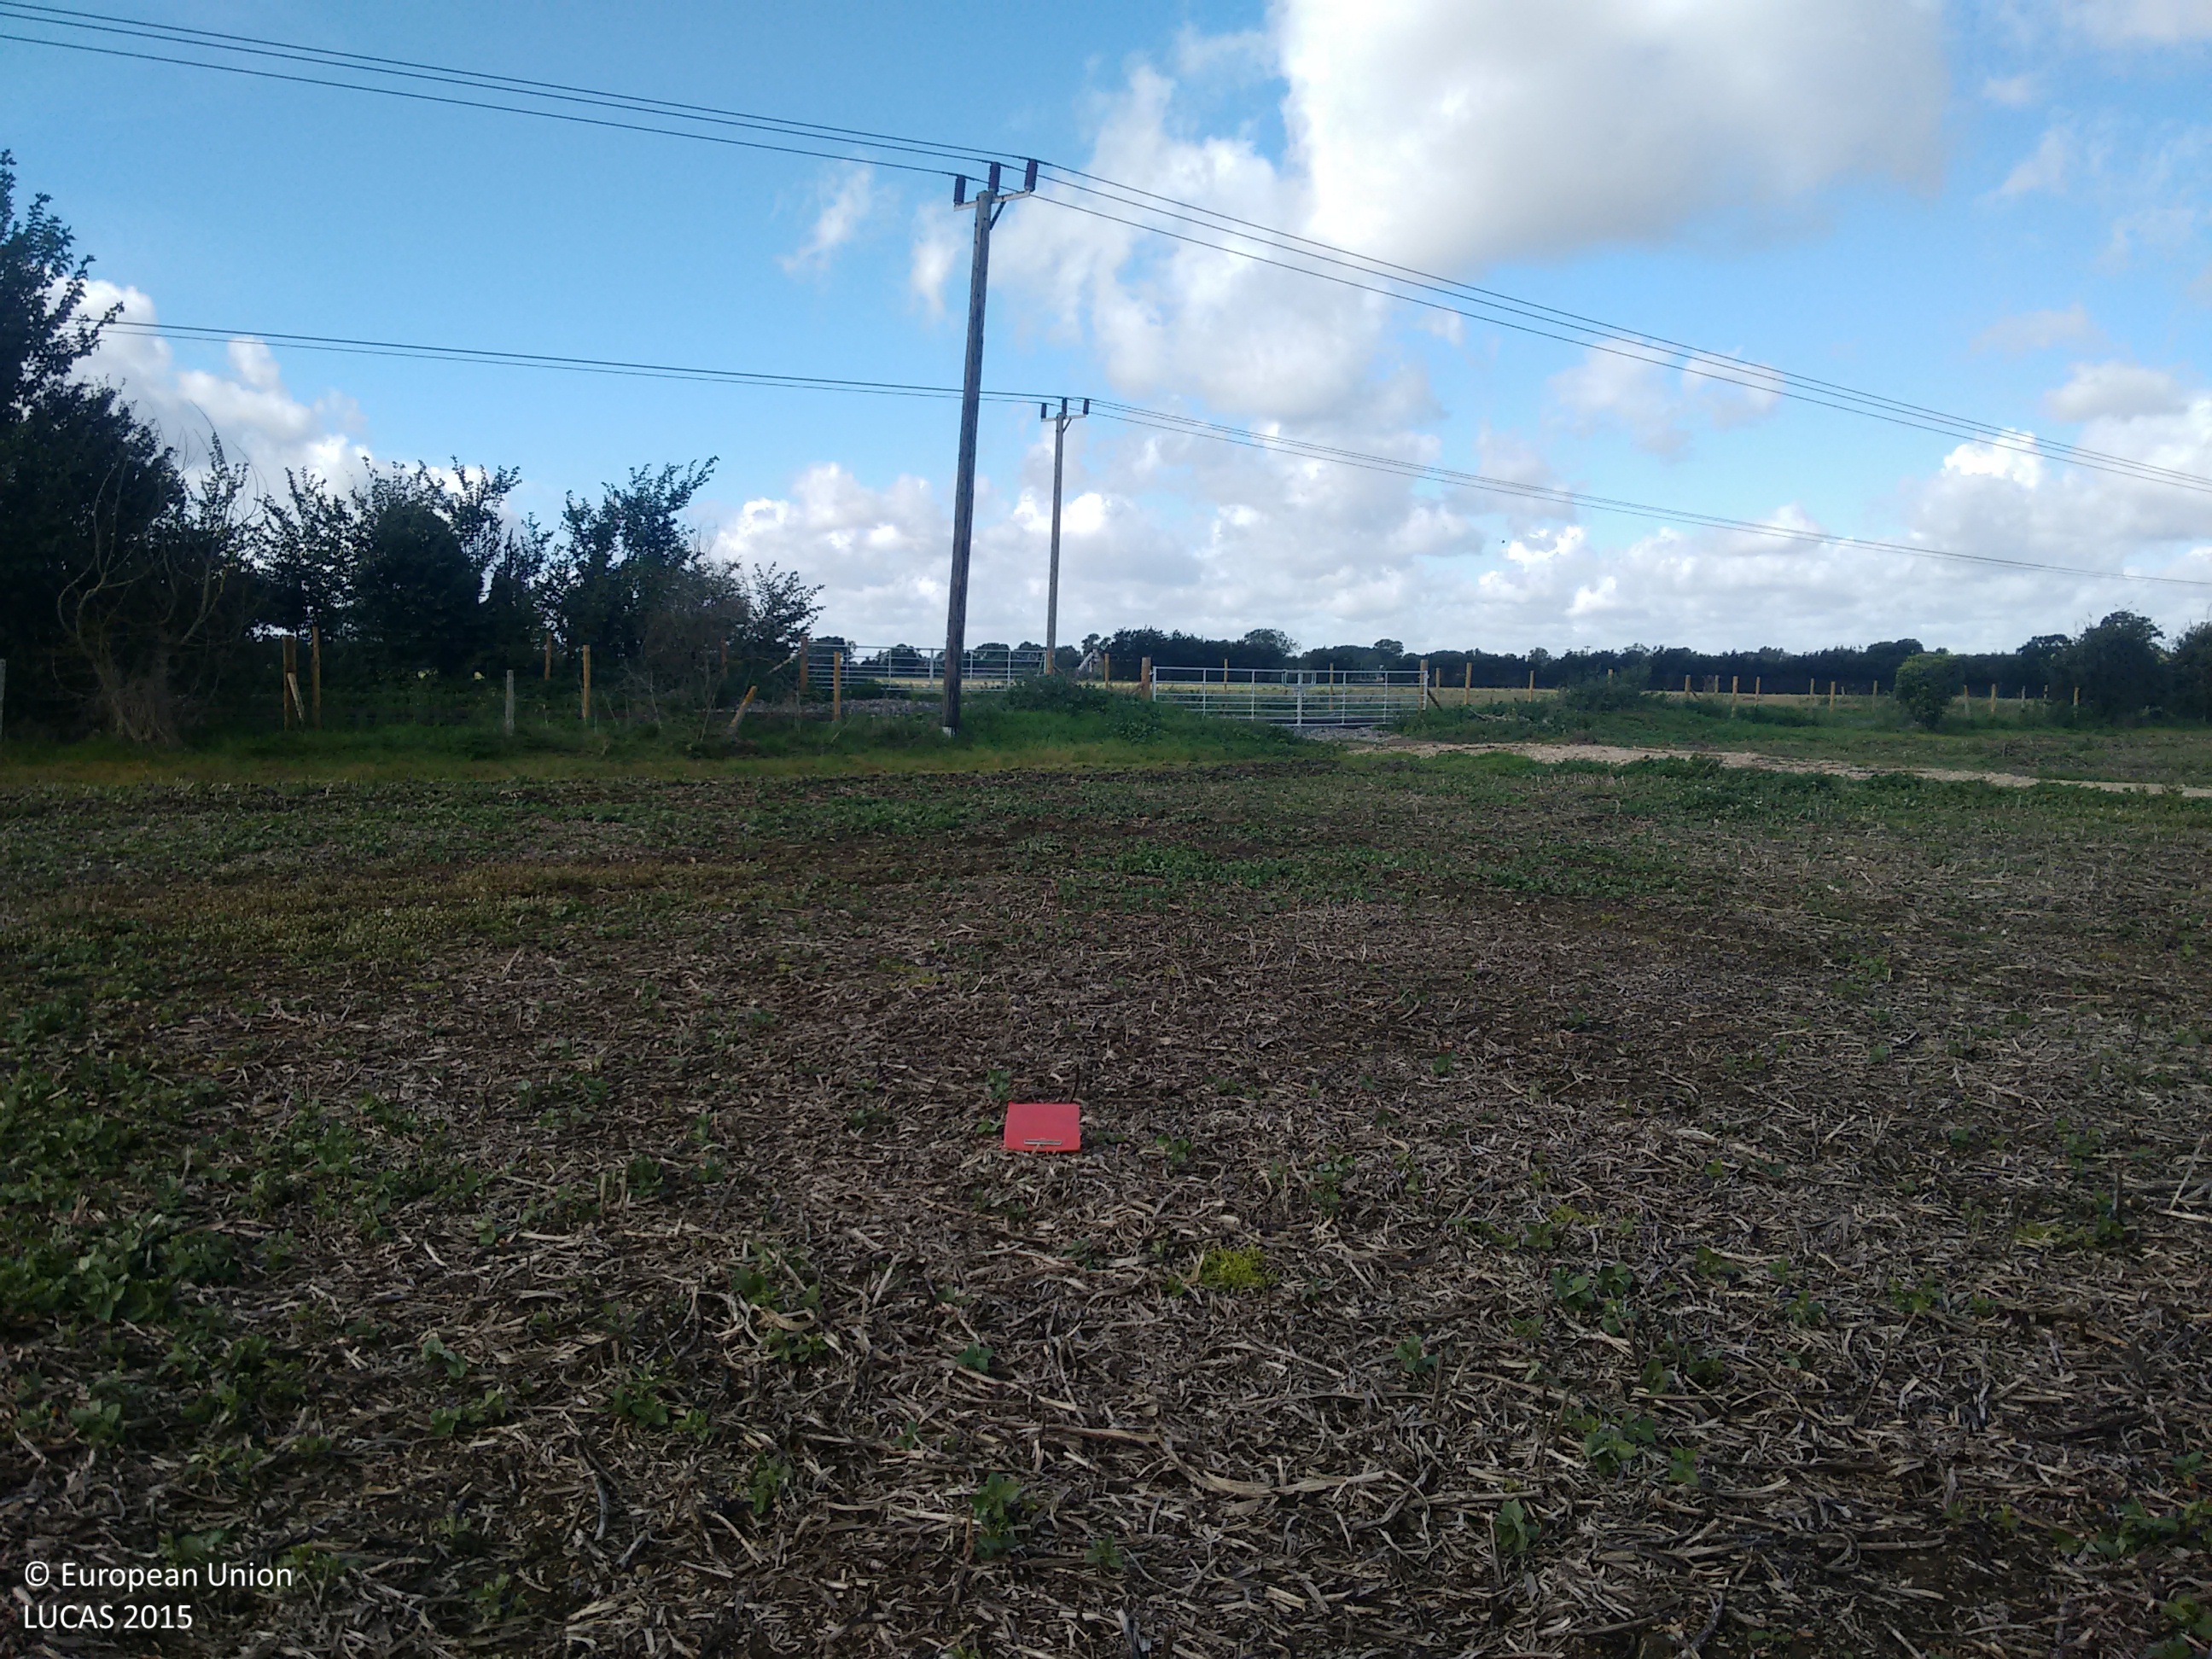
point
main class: Cropland
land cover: Dry pulses
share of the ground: 50 - 75 %
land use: Agriculture (excluding fallow land and kitchen gardens)
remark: Harvested field
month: September
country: GB
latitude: 52.1216
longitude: 0.0507
